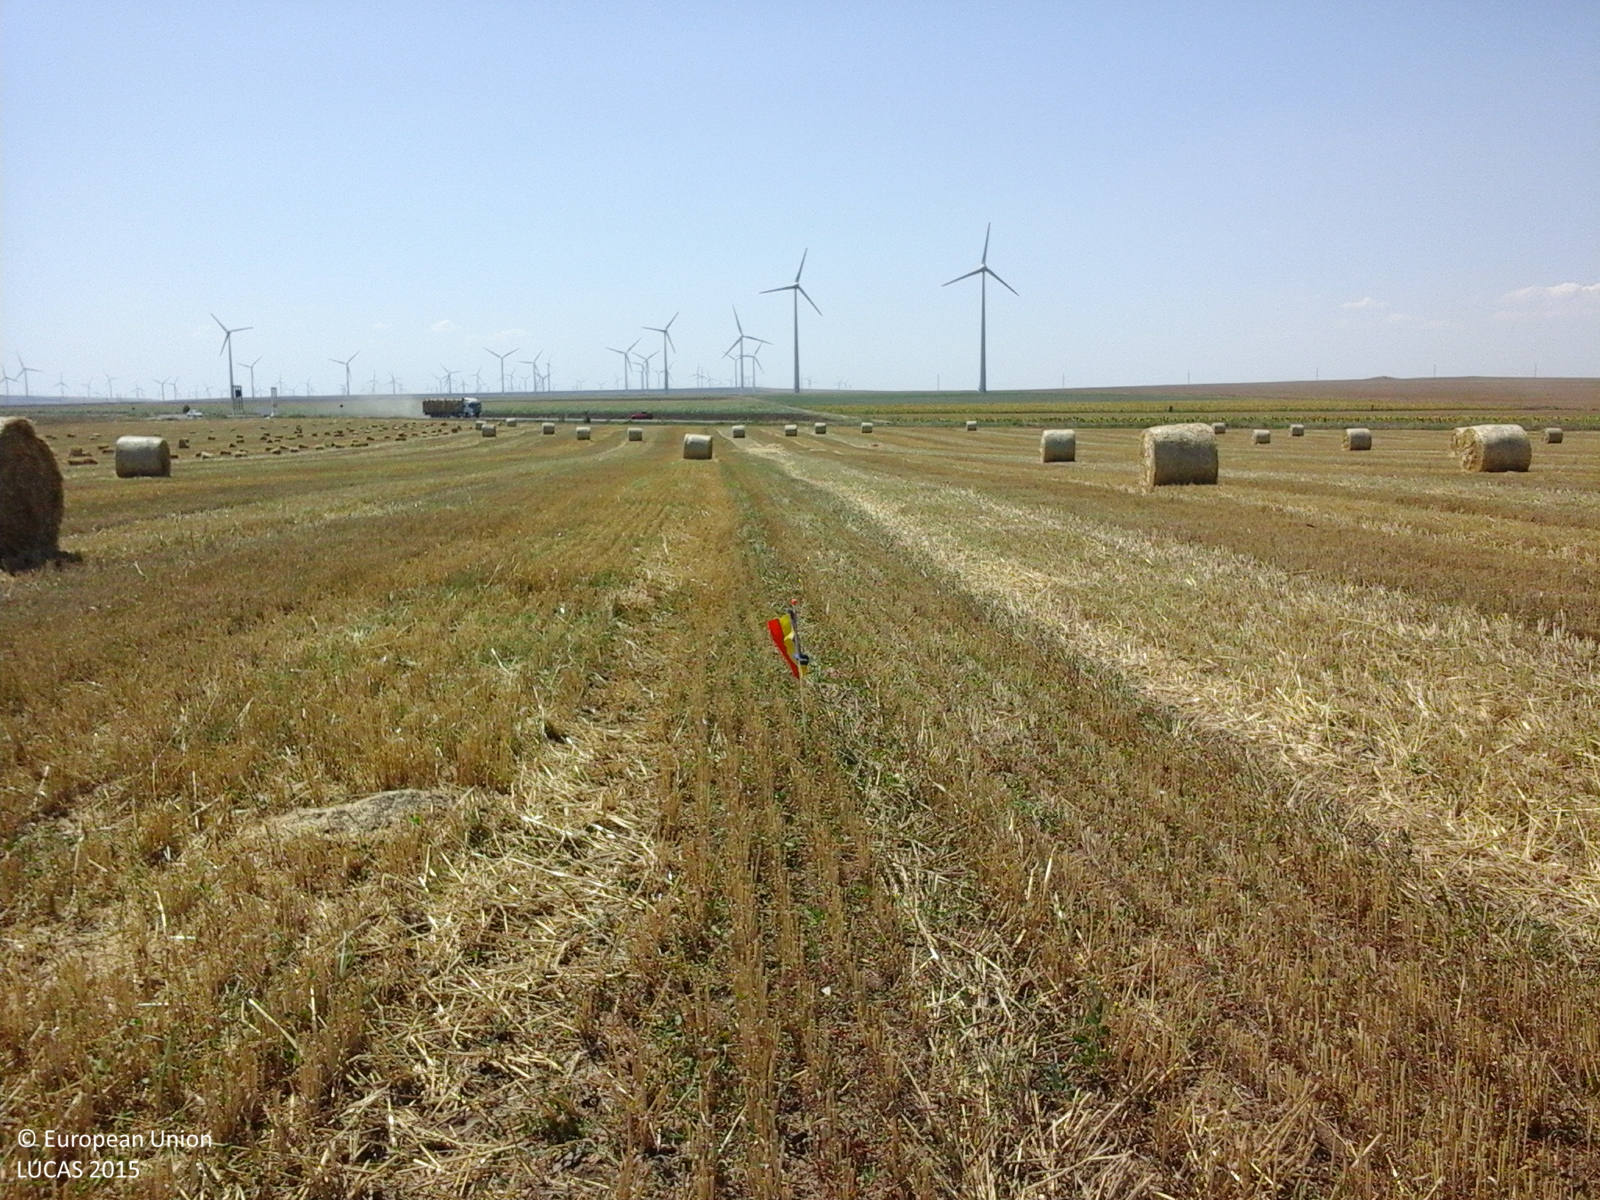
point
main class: Cropland
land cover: Common wheat
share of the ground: > 75 %
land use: Agriculture (excluding fallow land and kitchen gardens)
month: August
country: RO
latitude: 44.6669
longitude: 28.6852
